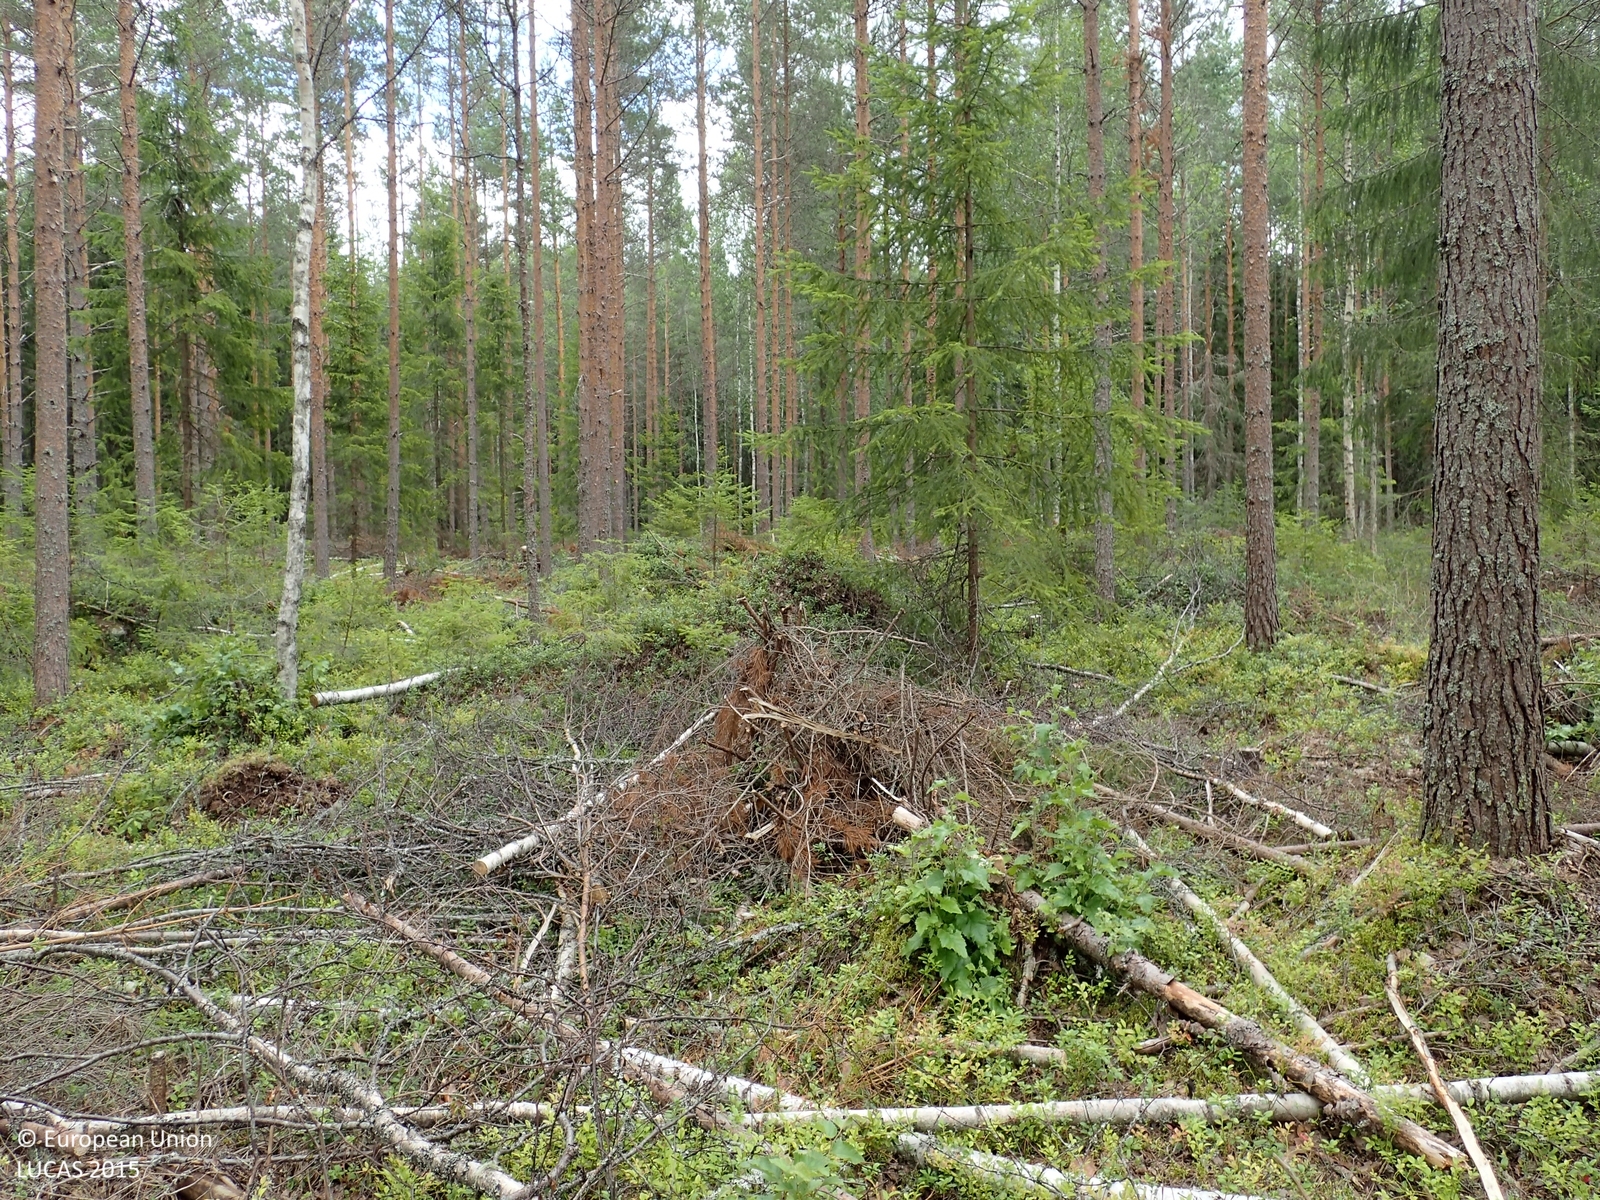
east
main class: Woodland
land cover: Pine dominated coniferous woodland
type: boreal forest
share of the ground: 25 - 50 %
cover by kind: coniferous forest trees 40 %, shrubs 40 %, lichens and mosses 5 %
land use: Forestry
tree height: > 5 m
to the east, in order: Pine dominated coniferous woodland; Ditches and canals; Pine dominated coniferous woodland; Ditches and canals; Other coniferous woodland; Ditches and canals; Abandoned hedges; Grass margins; Paved roads, cycling and walking lanes; Grass margins; Ditches and canals; Shruby margins; Spruce dominated coniferous woodland
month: August
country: FI
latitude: 62.6779
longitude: 21.7821
